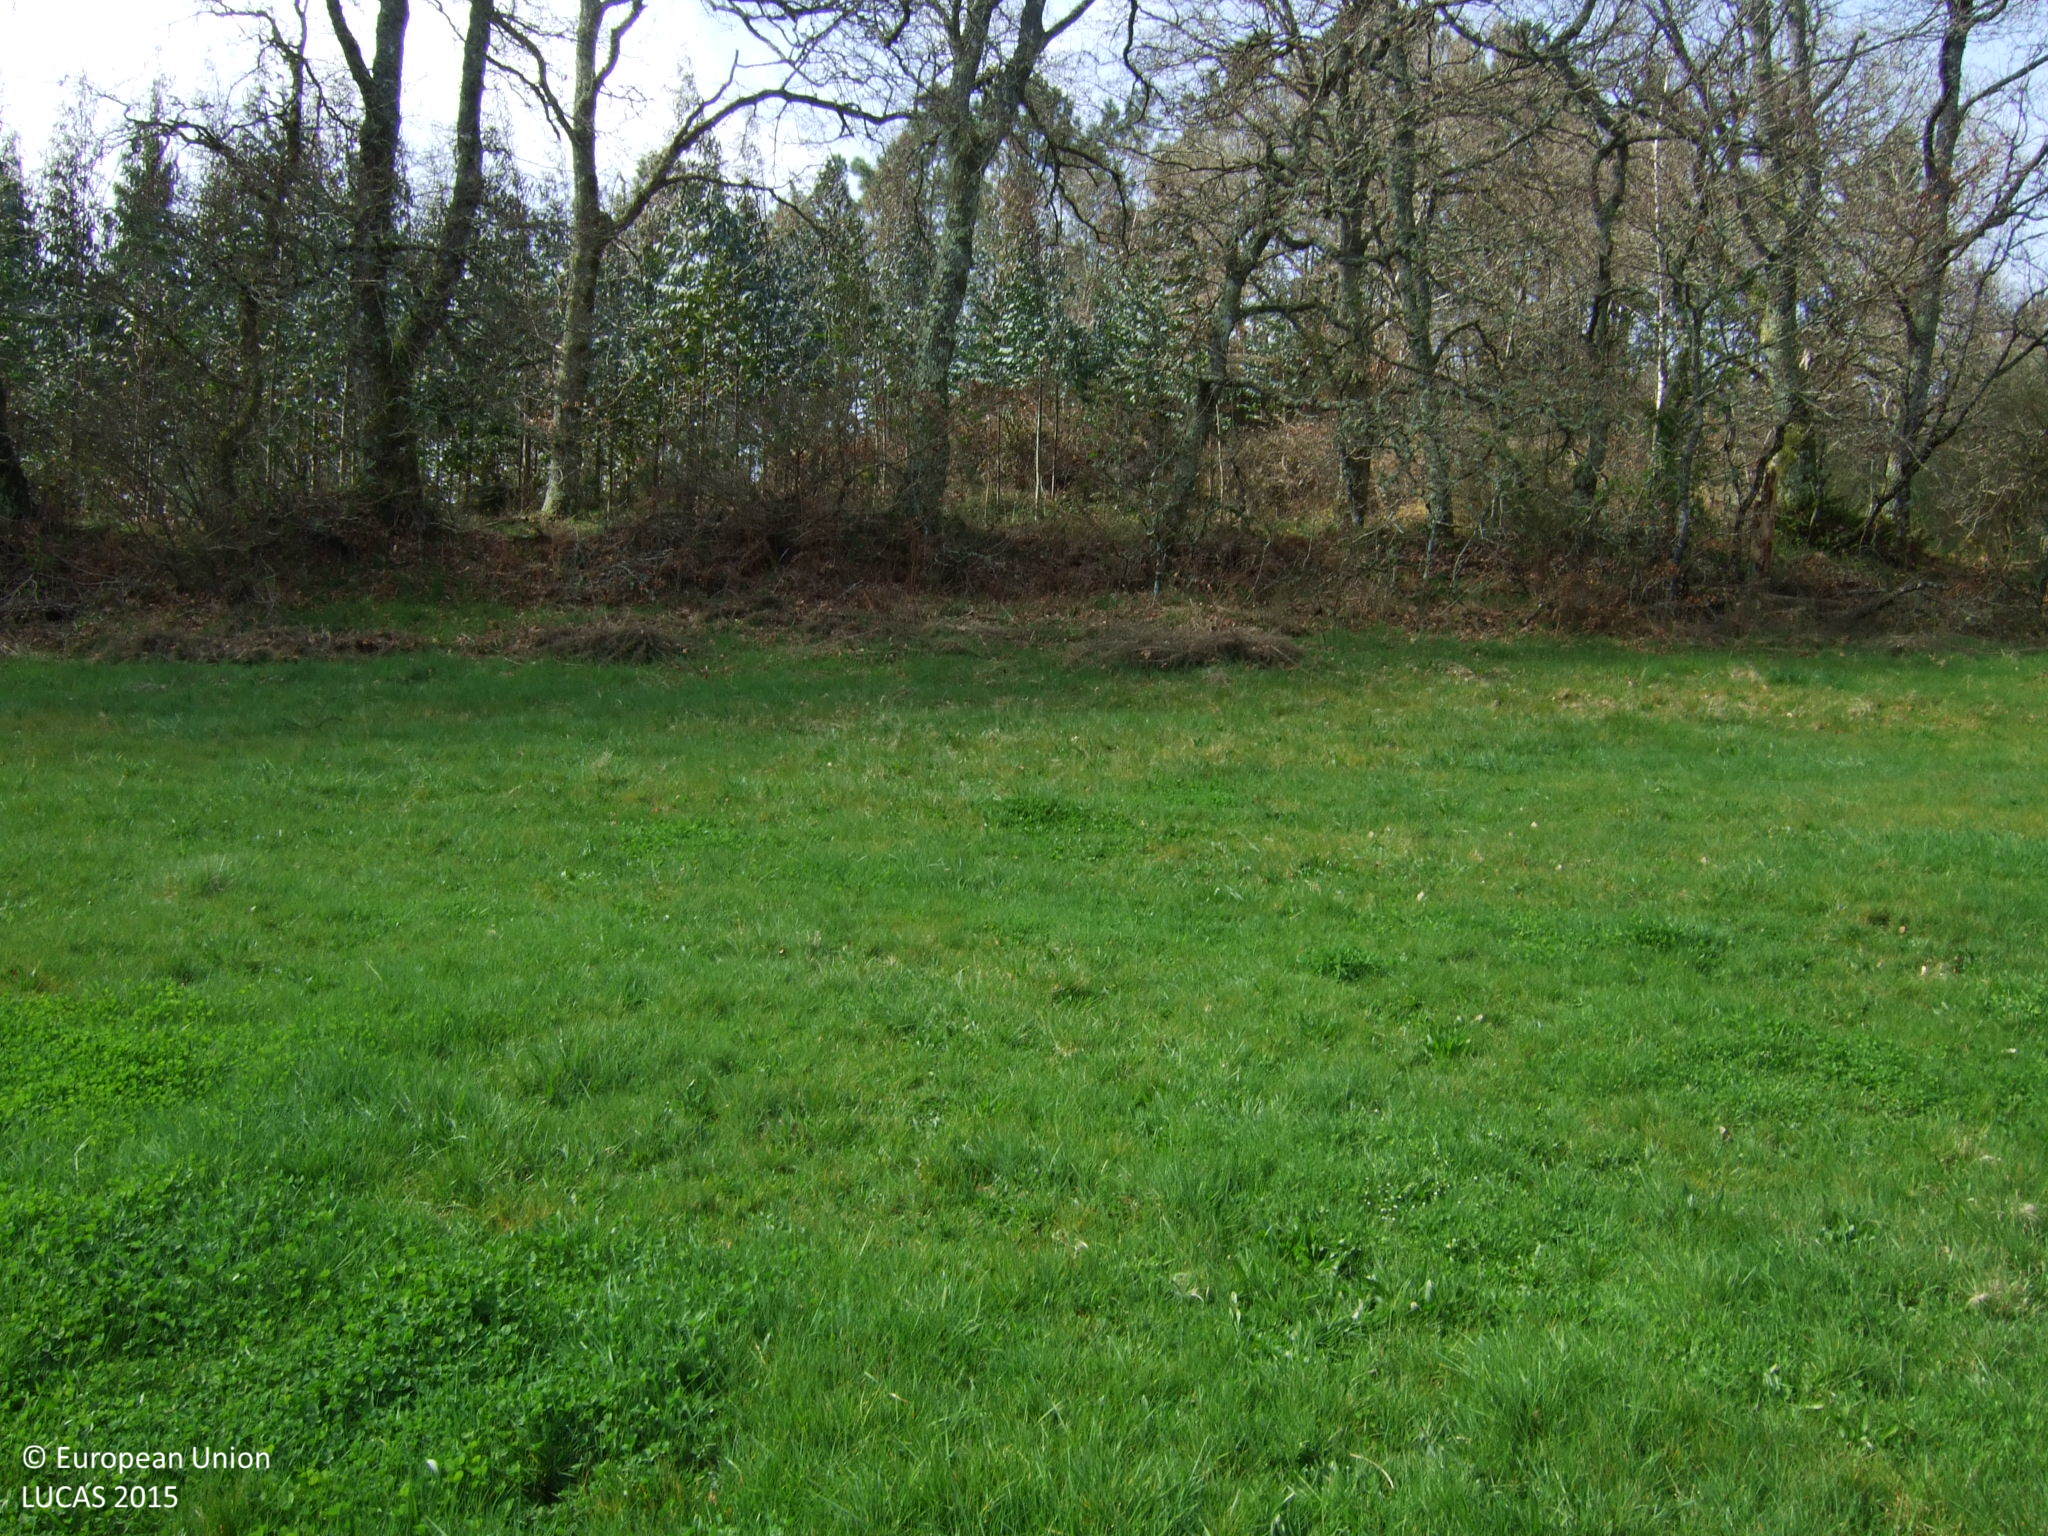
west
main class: Grassland
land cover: Grassland without tree/shrub cover
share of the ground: > 75 %
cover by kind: herbaceous plants 100 %
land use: Agriculture (excluding fallow land and kitchen gardens)
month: March
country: ES
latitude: 42.8931
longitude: -7.8776
